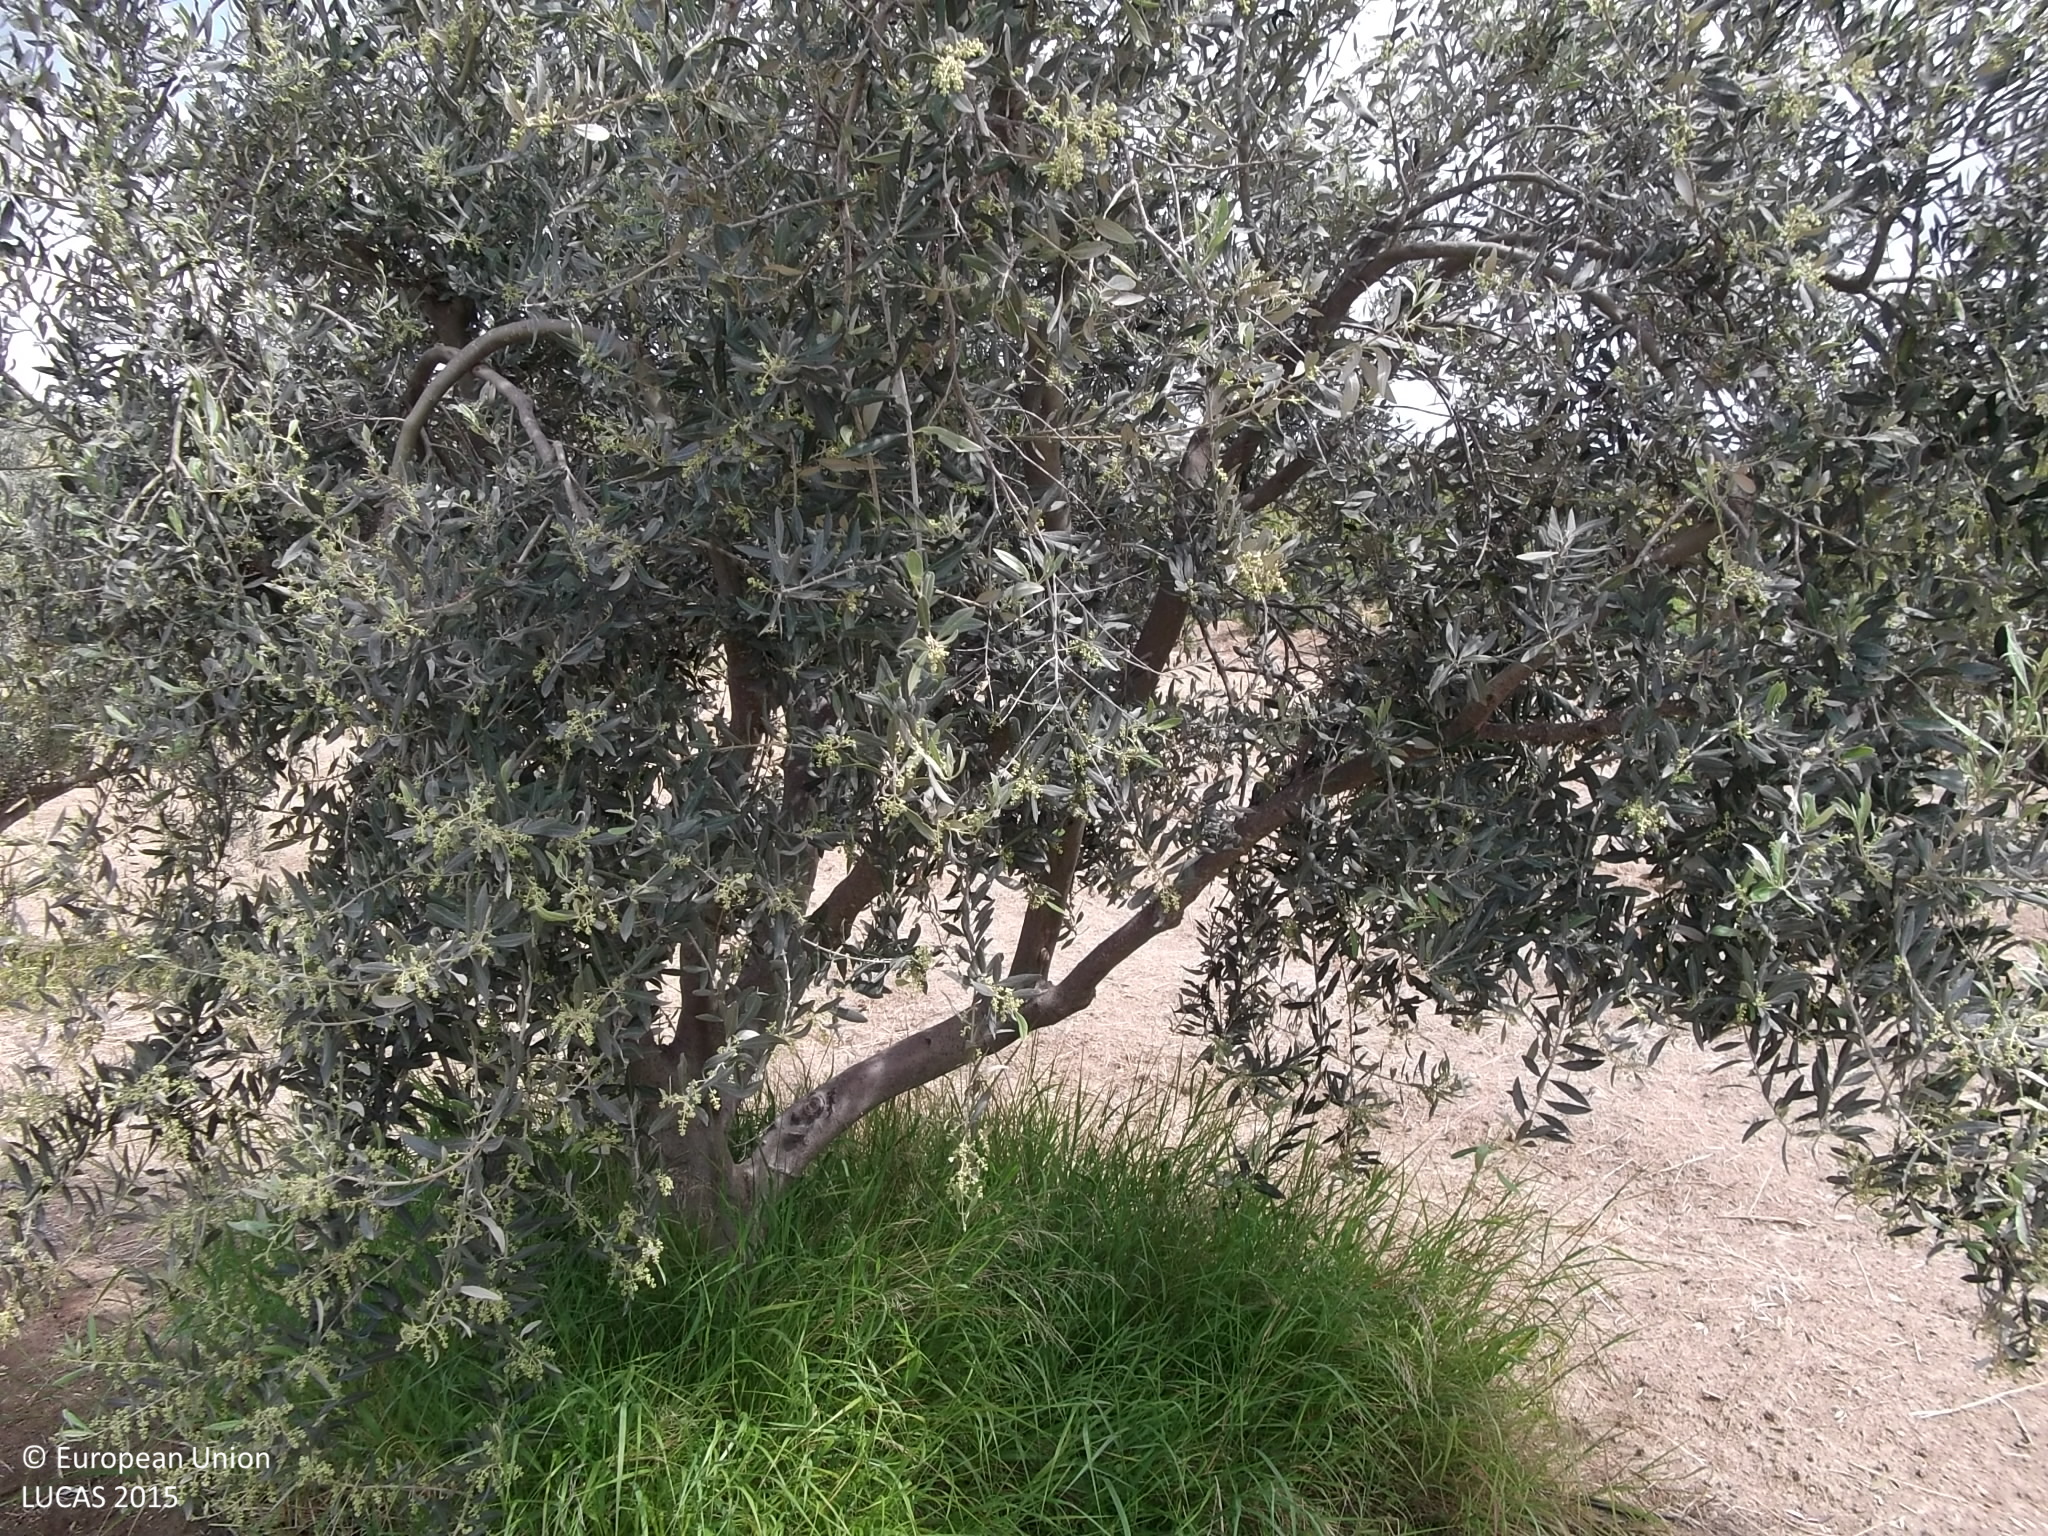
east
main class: Cropland
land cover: Olive groves
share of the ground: 25 - 50 %
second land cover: Other bare soil
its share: > 75 %
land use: Agriculture (excluding fallow land and kitchen gardens)
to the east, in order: Olive groves; Other bare soil; Olive groves; Lines of trees; Tracks; Grass margins; Fences; Oranges; Artificial constructions in urban areas; Oranges; Paved roads, cycling and walking lanes; Artificial constructions in urban areas; Shrubland without tree cover; Tracks; Shrubland without tree cover; Mixed cereals for fodder
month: April
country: CY
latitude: 34.7660
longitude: 33.3990
